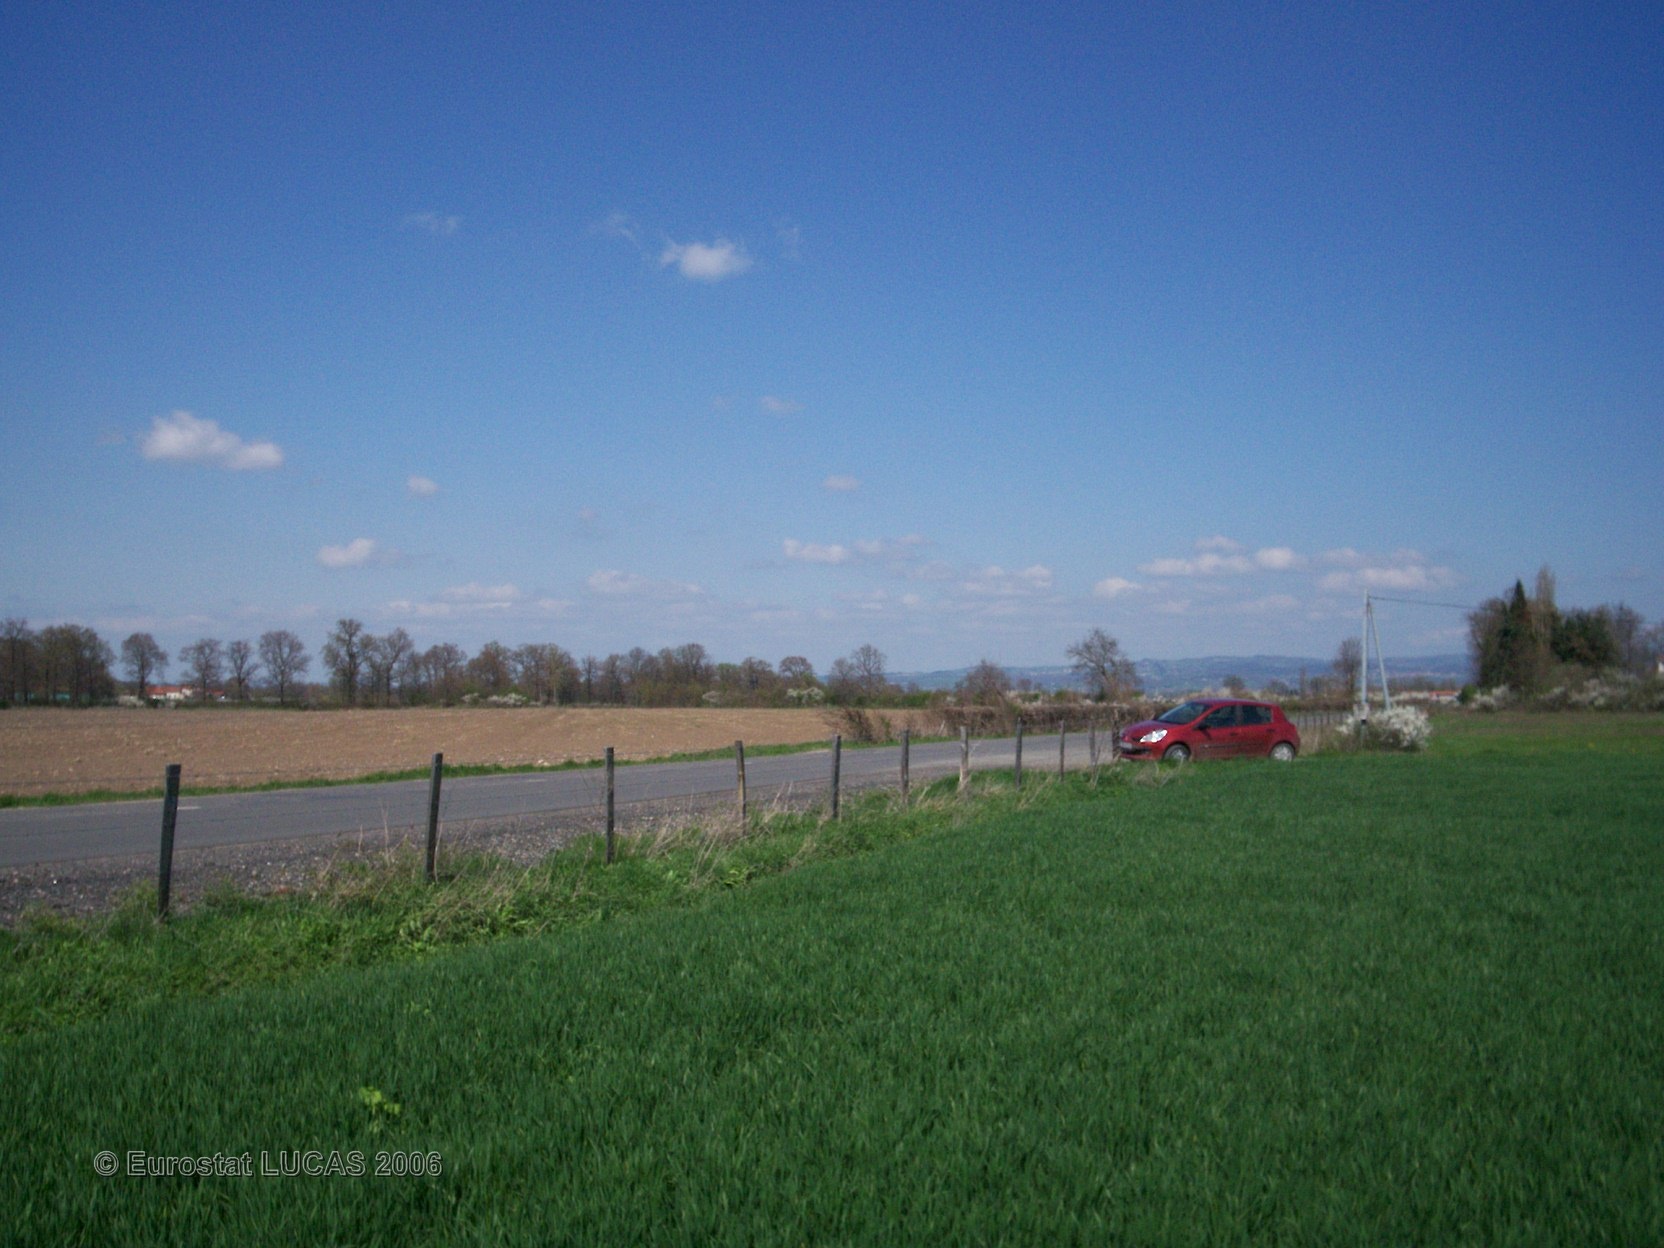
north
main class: Cropland
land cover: Common wheat
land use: Agriculture (excluding fallow land and kitchen gardens)
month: April
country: FR
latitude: 45.7054
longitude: 4.1842
